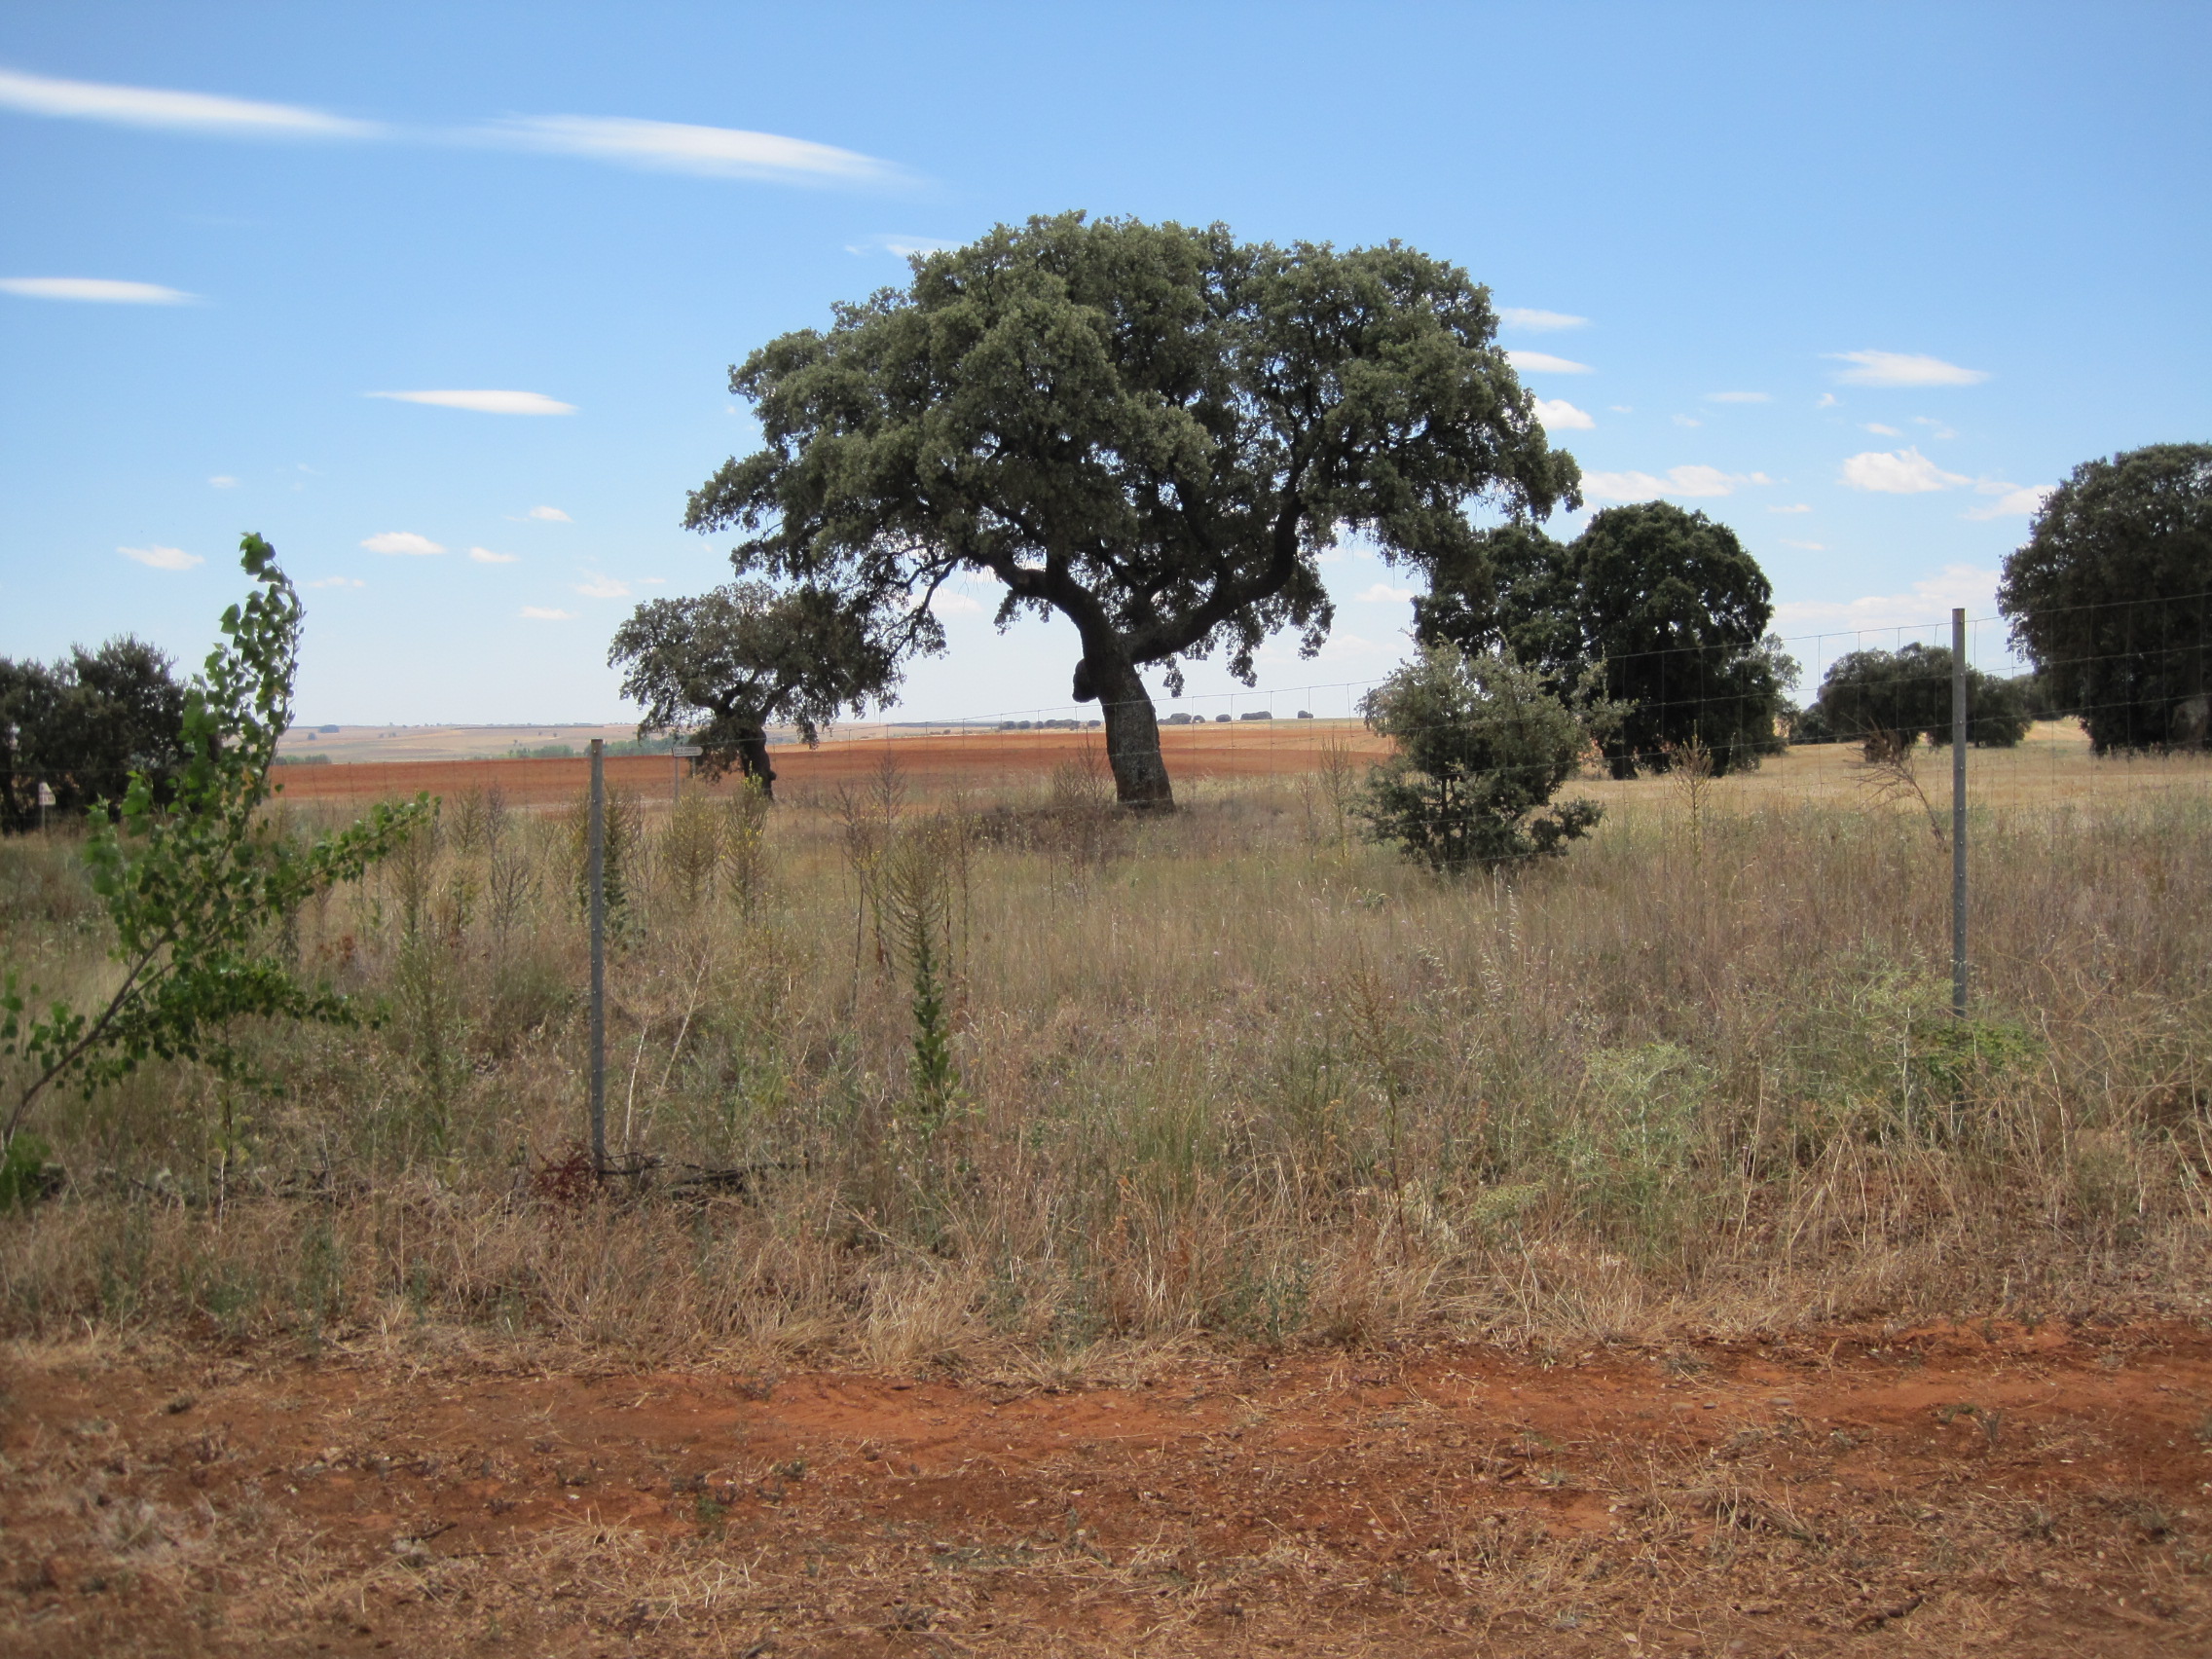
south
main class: Woodland
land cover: Broadleaved woodland
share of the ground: 25 - 50 %
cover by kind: unconsolidated bare surface 60 %, broadleaved forest trees 25 %, herbaceous plants 15 %
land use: Semi-natural and natural areas not in use
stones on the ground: 25 - 50 %
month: July
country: ES
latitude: 42.0477
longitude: -5.5669
